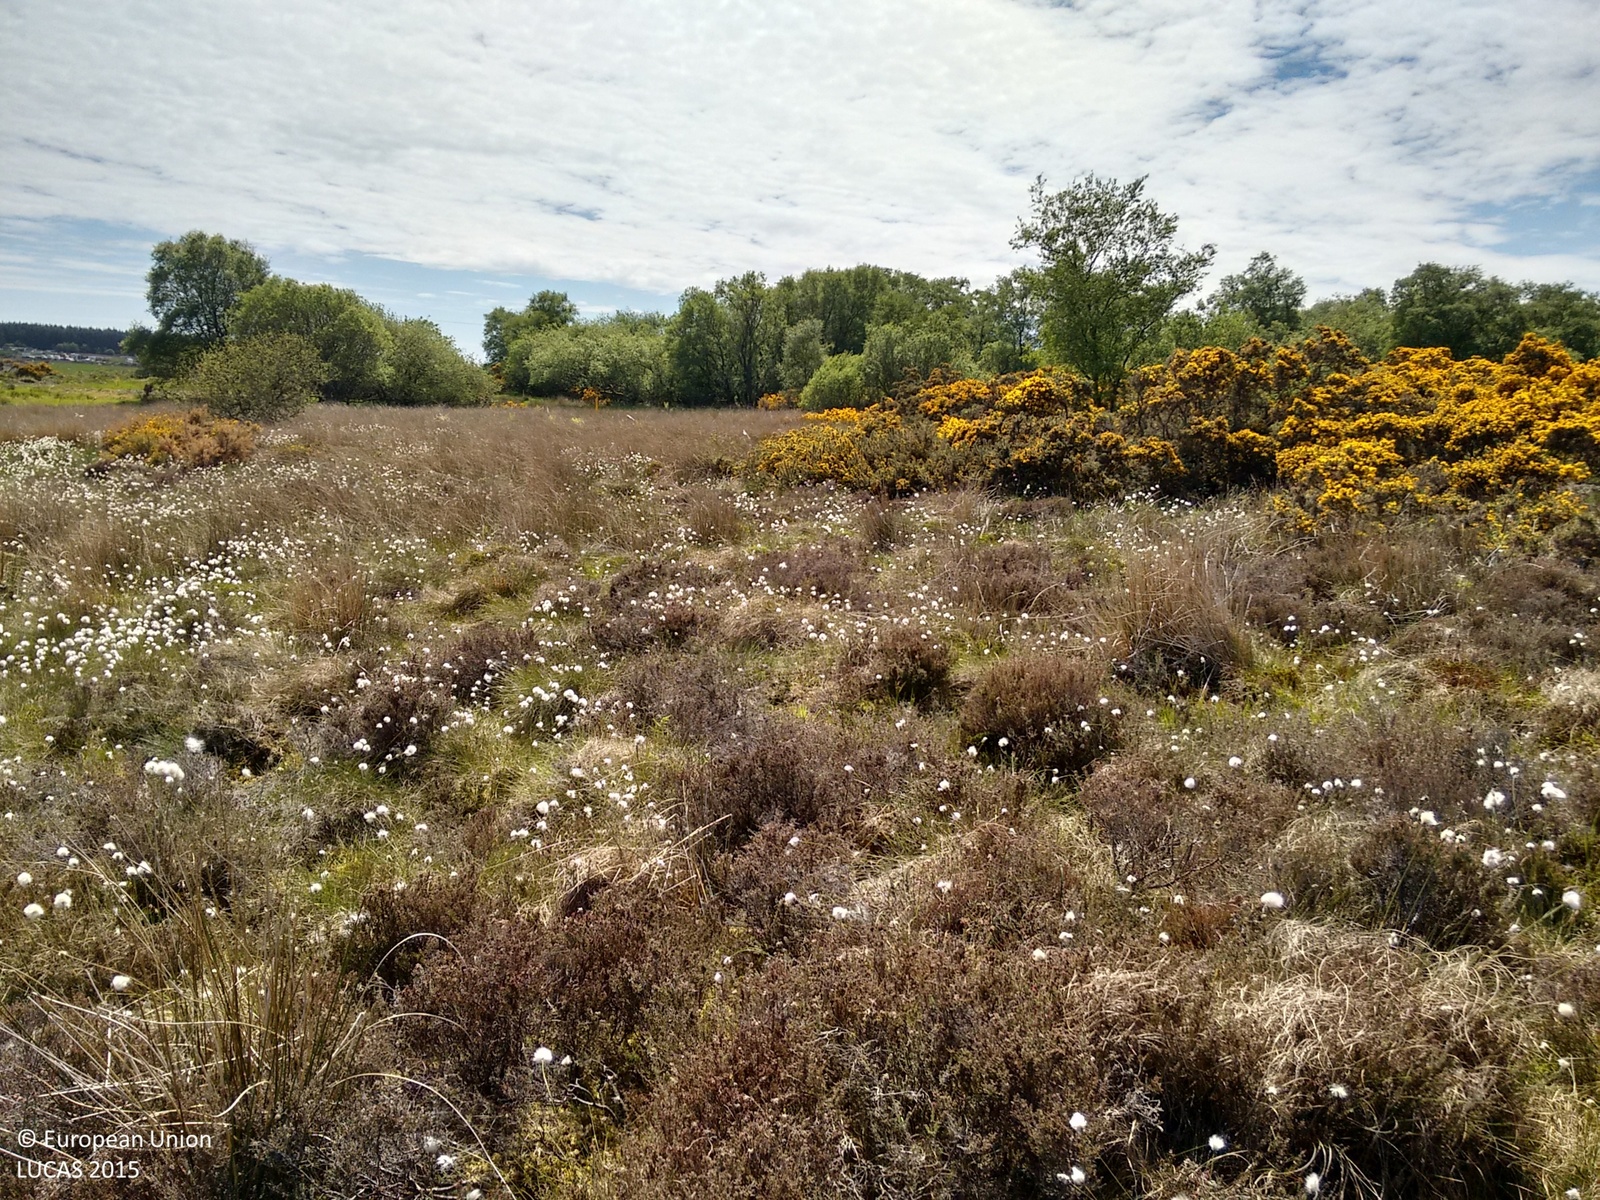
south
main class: Shrubland
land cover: Shrubland without tree cover
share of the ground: > 75 %
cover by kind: shrubs 65 %, herbaceous plants 20 %, lichens and mosses 15 %
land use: Semi-natural and natural areas not in use
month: June
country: GB
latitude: 57.0036
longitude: -2.2177
